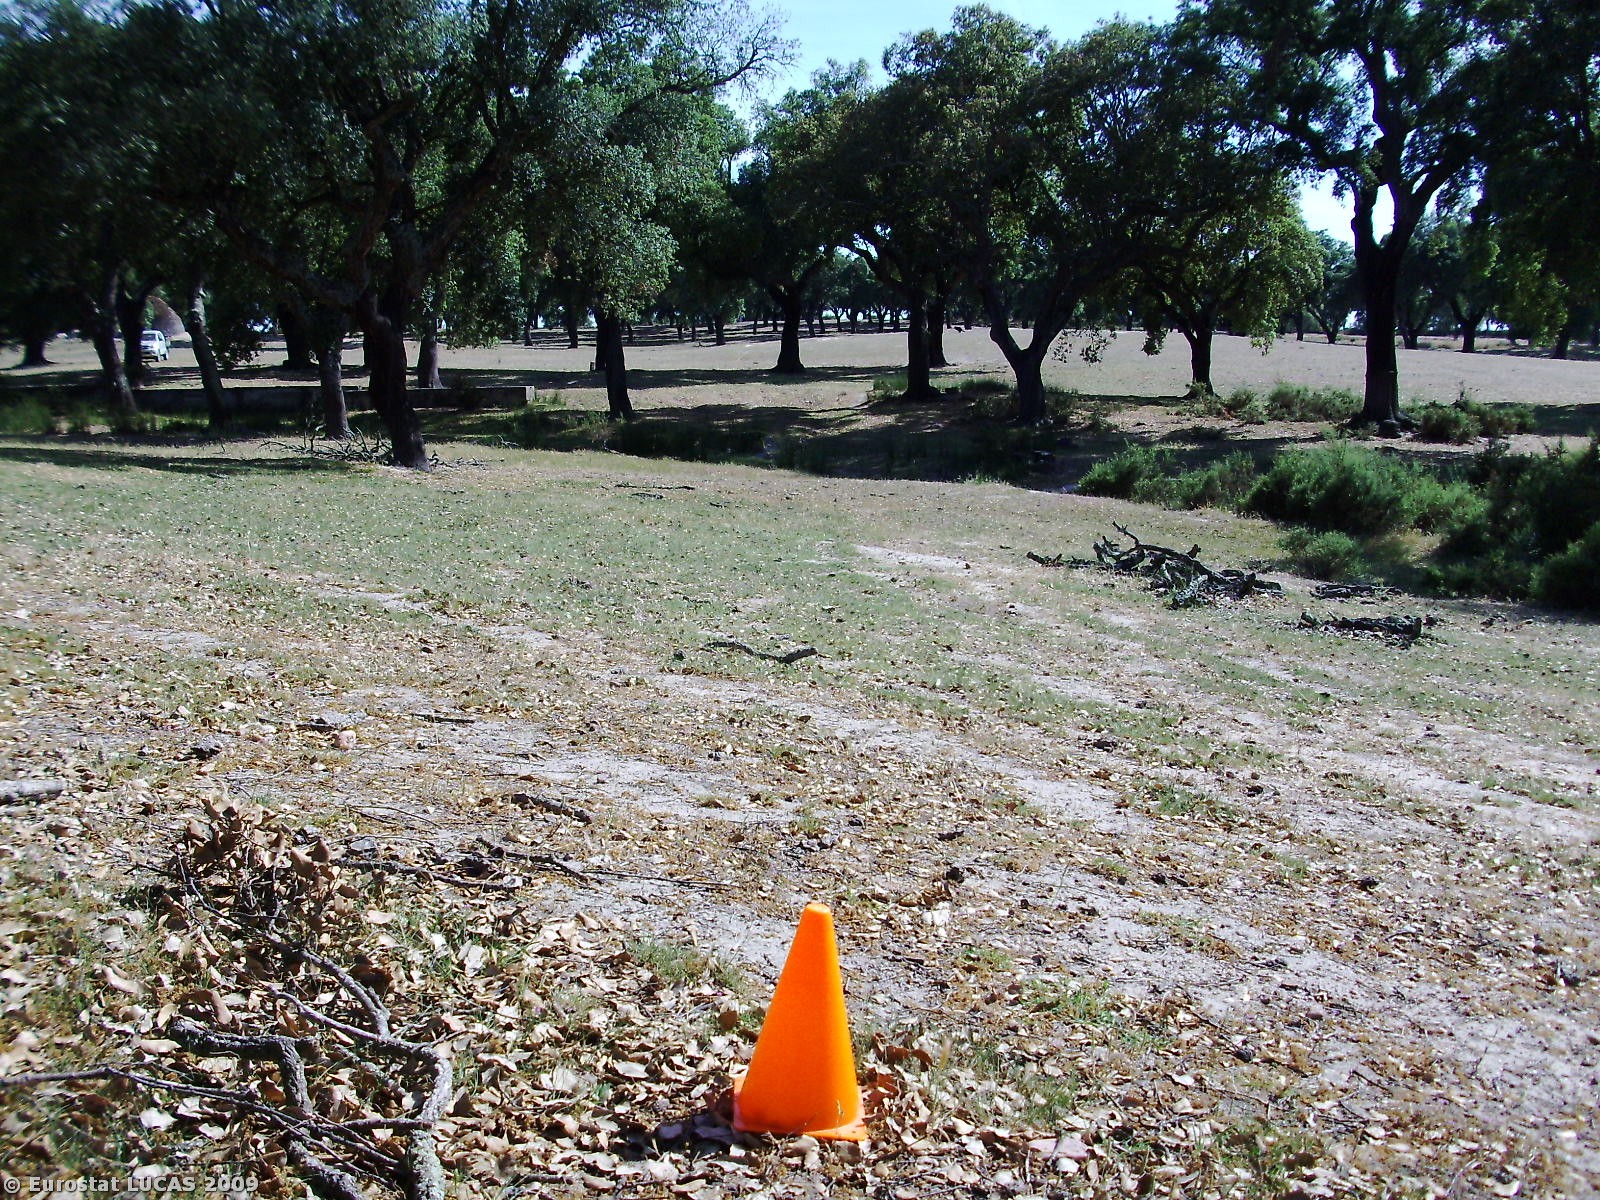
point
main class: Woodland
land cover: Broadleaved woodland
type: broadleaved evergreen forest
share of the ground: 50 - 75 %
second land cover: Grassland with sparse tree/shrub cover
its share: 25 - 50 %
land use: Forestry
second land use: Agriculture (excluding fallow land and kitchen gardens)
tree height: > 5 m
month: May
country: PT
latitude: 39.0936
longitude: -7.9601
